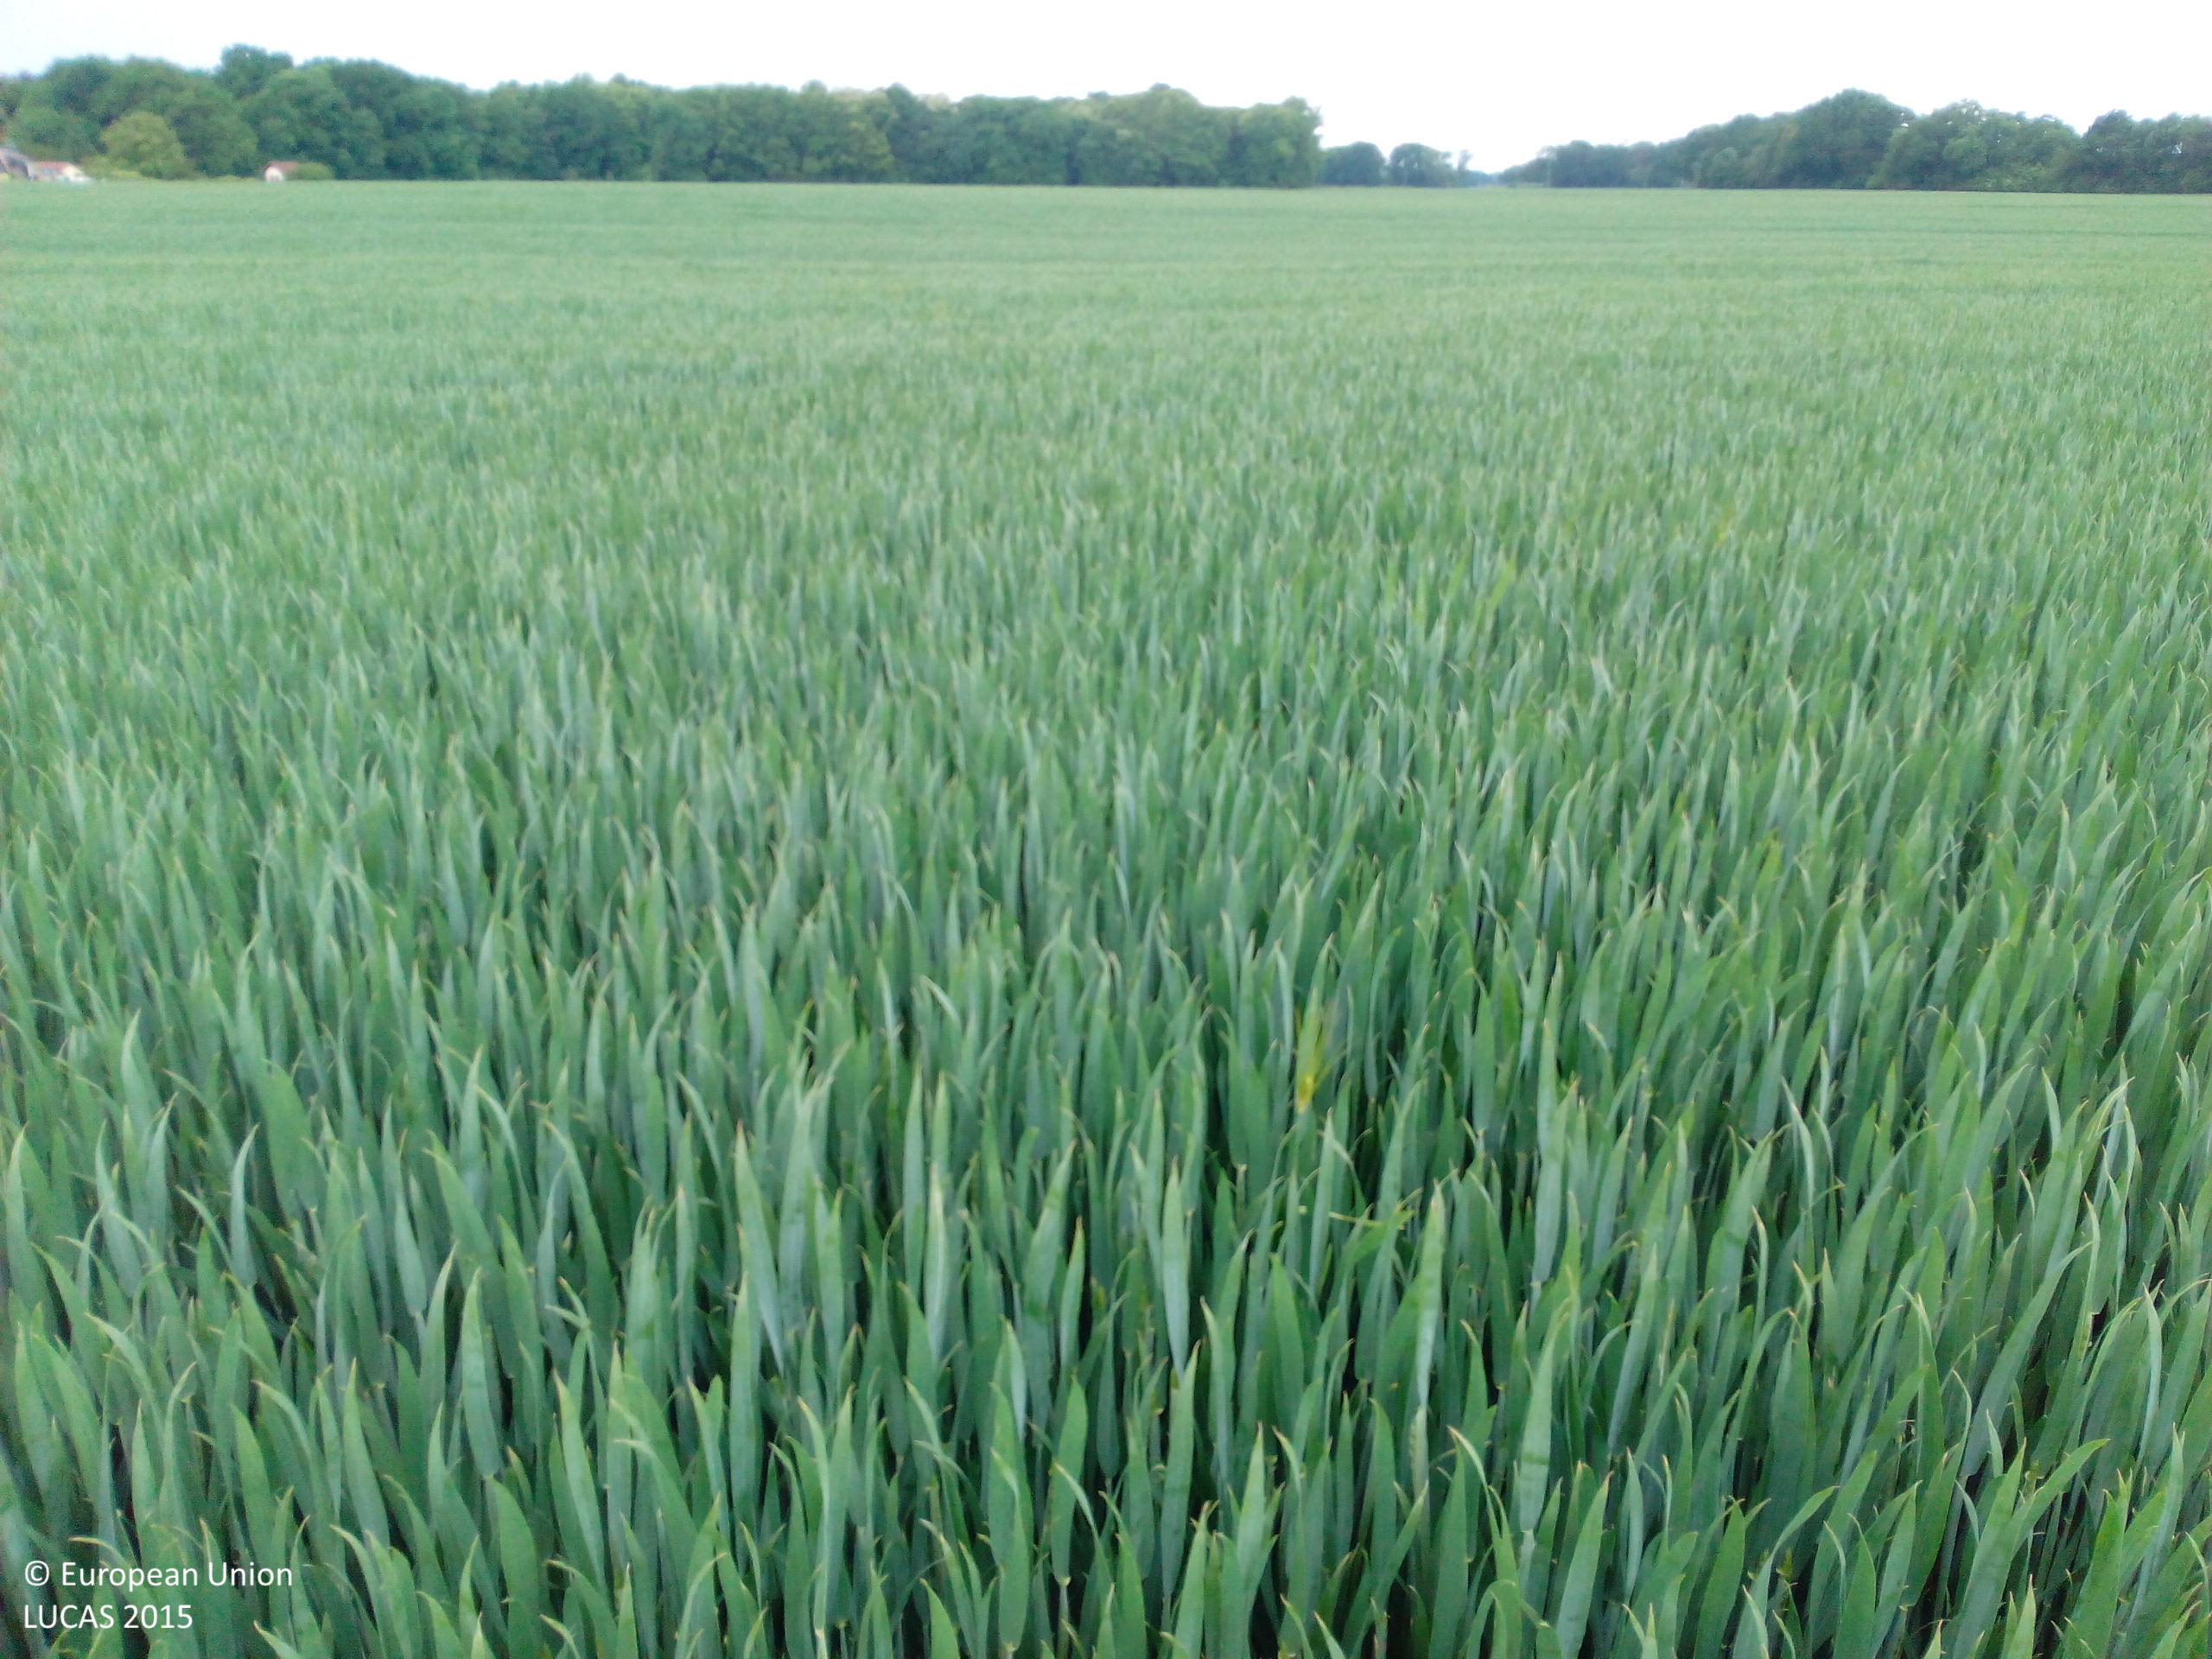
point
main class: Cropland
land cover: Common wheat
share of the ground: > 75 %
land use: Agriculture (excluding fallow land and kitchen gardens)
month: May
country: DE
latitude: 51.5947
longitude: 12.5549
